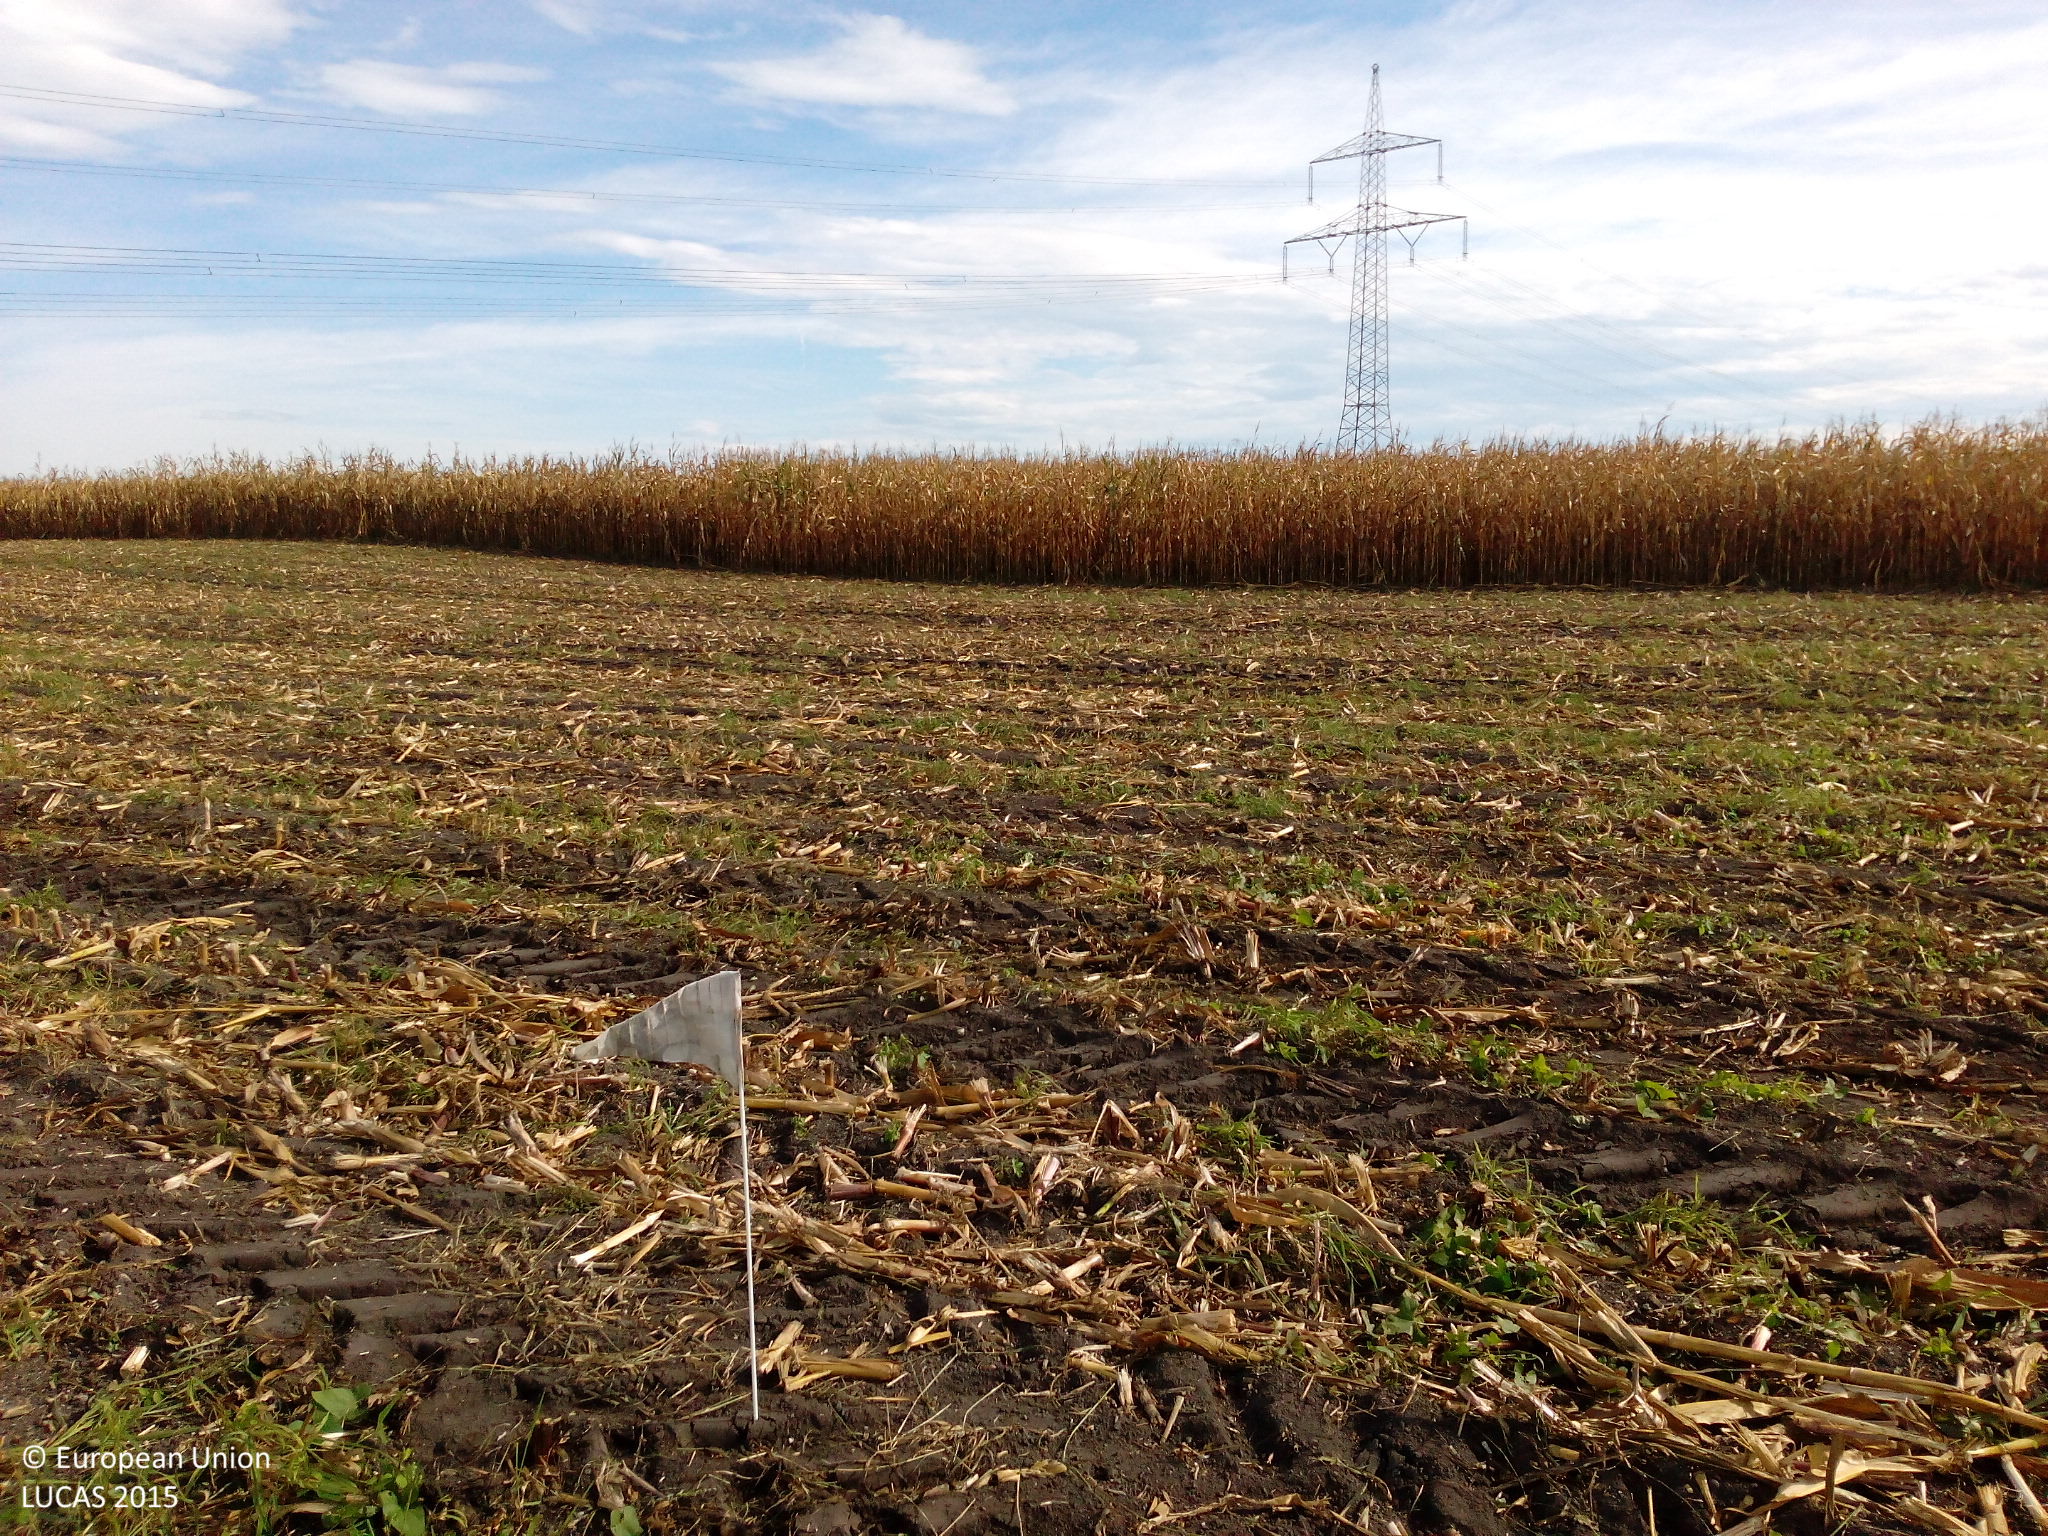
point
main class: Cropland
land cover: Maize
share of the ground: < 10 %
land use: Agriculture (excluding fallow land and kitchen gardens)
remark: Harvested field
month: September
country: DE
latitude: 48.3691
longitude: 11.9025
